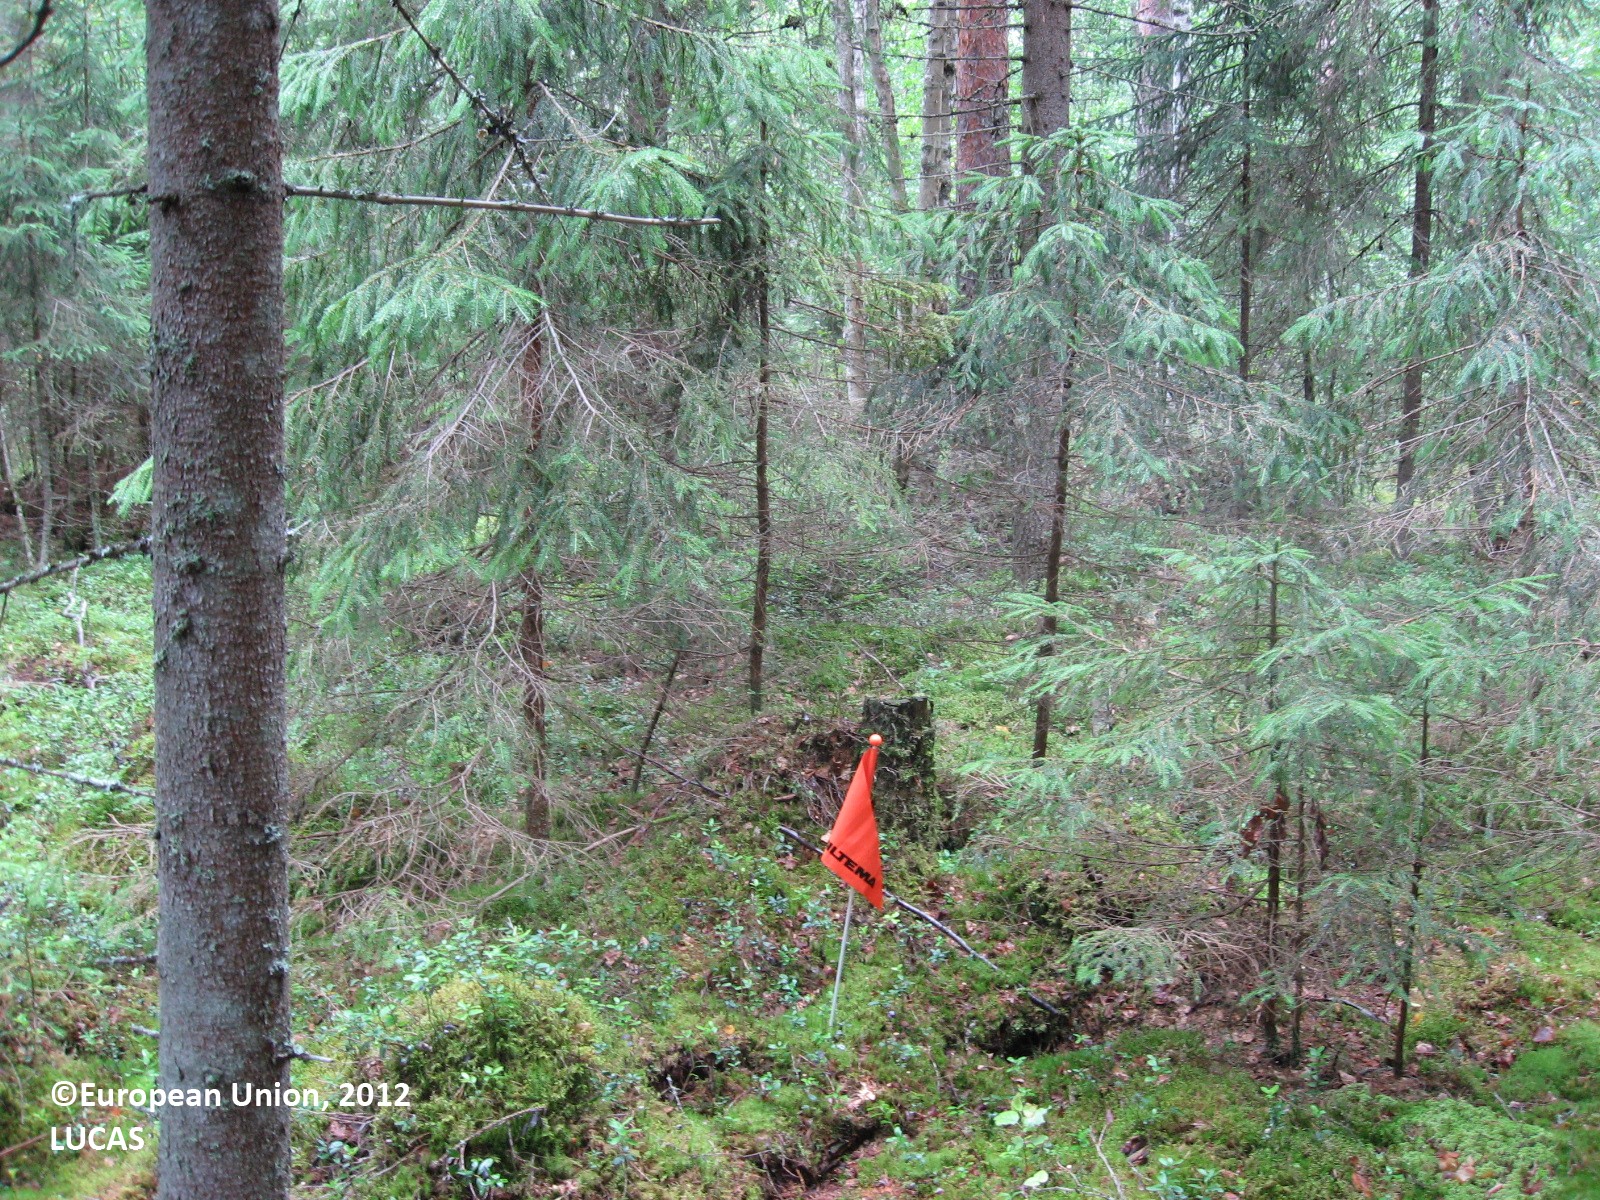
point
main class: Woodland
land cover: Spruce dominated mixed woodland
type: boreal forest
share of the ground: 50 - 75 %
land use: Forestry
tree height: > 5 m
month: July
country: FI
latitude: 61.3575
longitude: 25.8592
